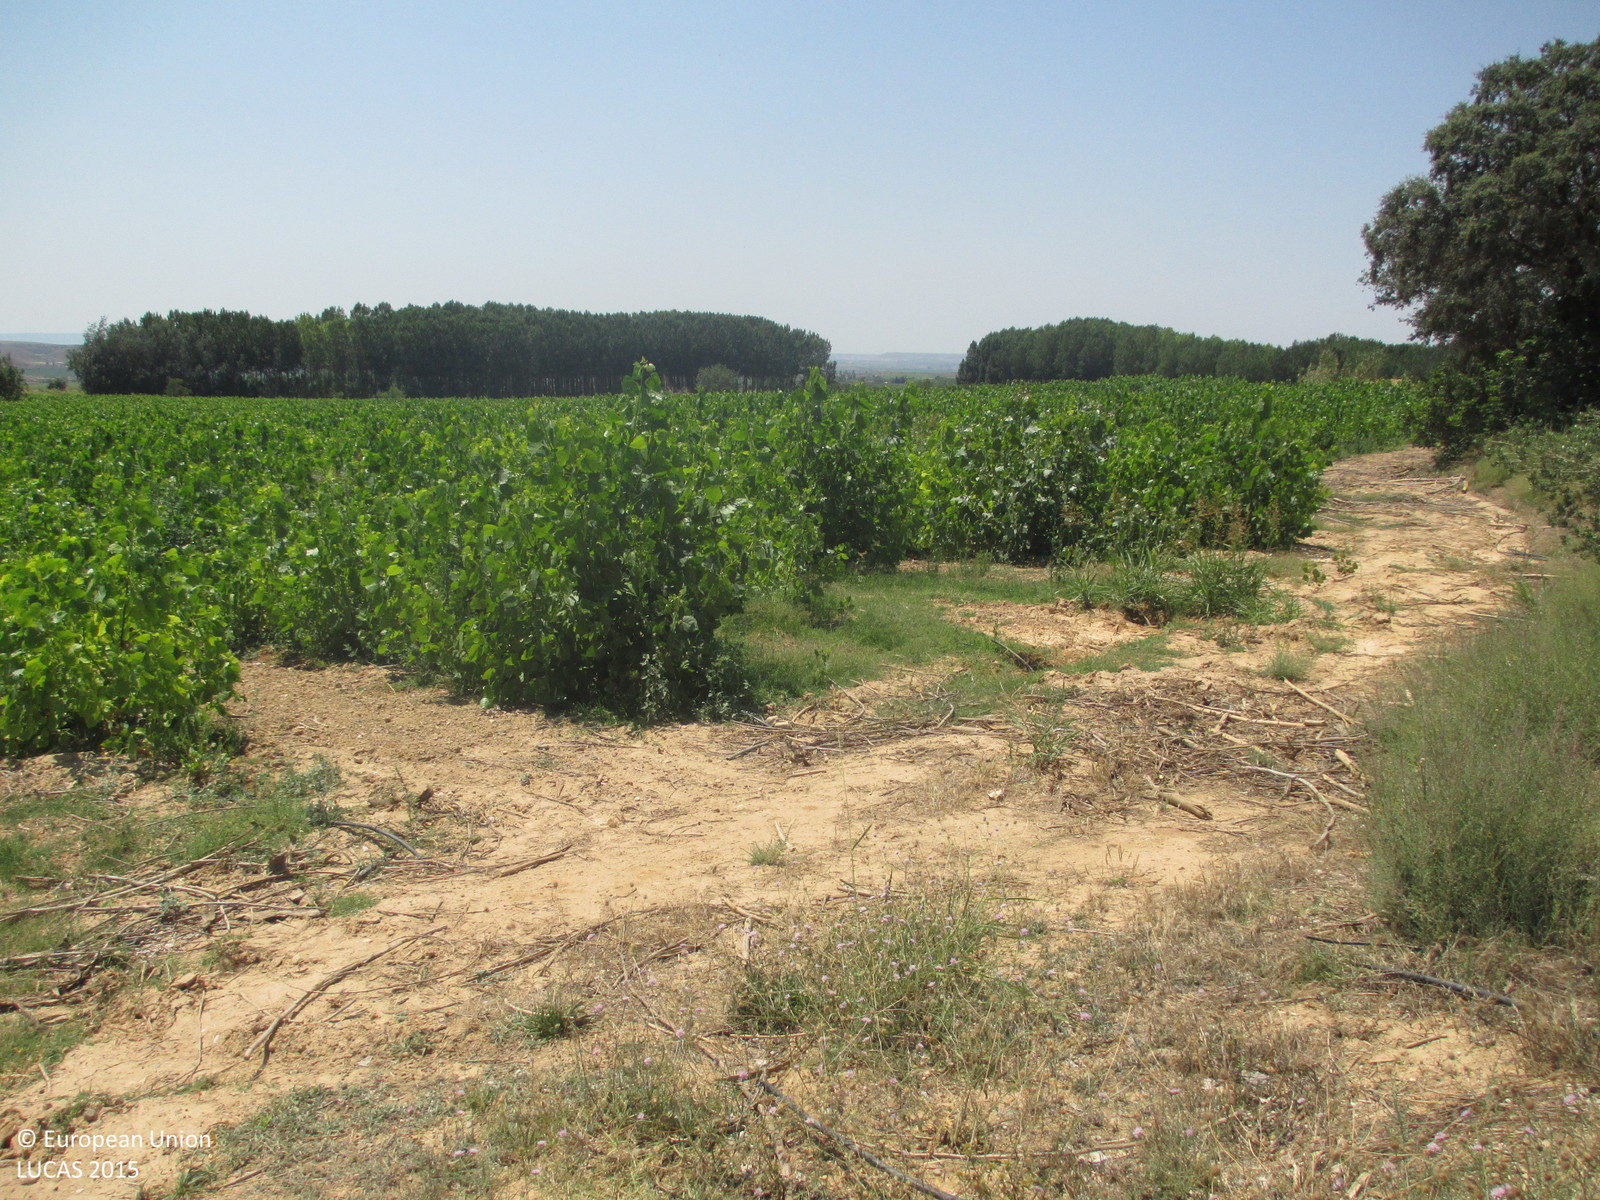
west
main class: Shrubland
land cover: Shrubland with sparse tree cover
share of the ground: > 75 %
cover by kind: shrubs 90 %, broadleaved forest trees 5 %, herbaceous plants 5 %
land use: Semi-natural and natural areas not in use
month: July
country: ES
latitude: 41.8519
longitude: 0.2153
